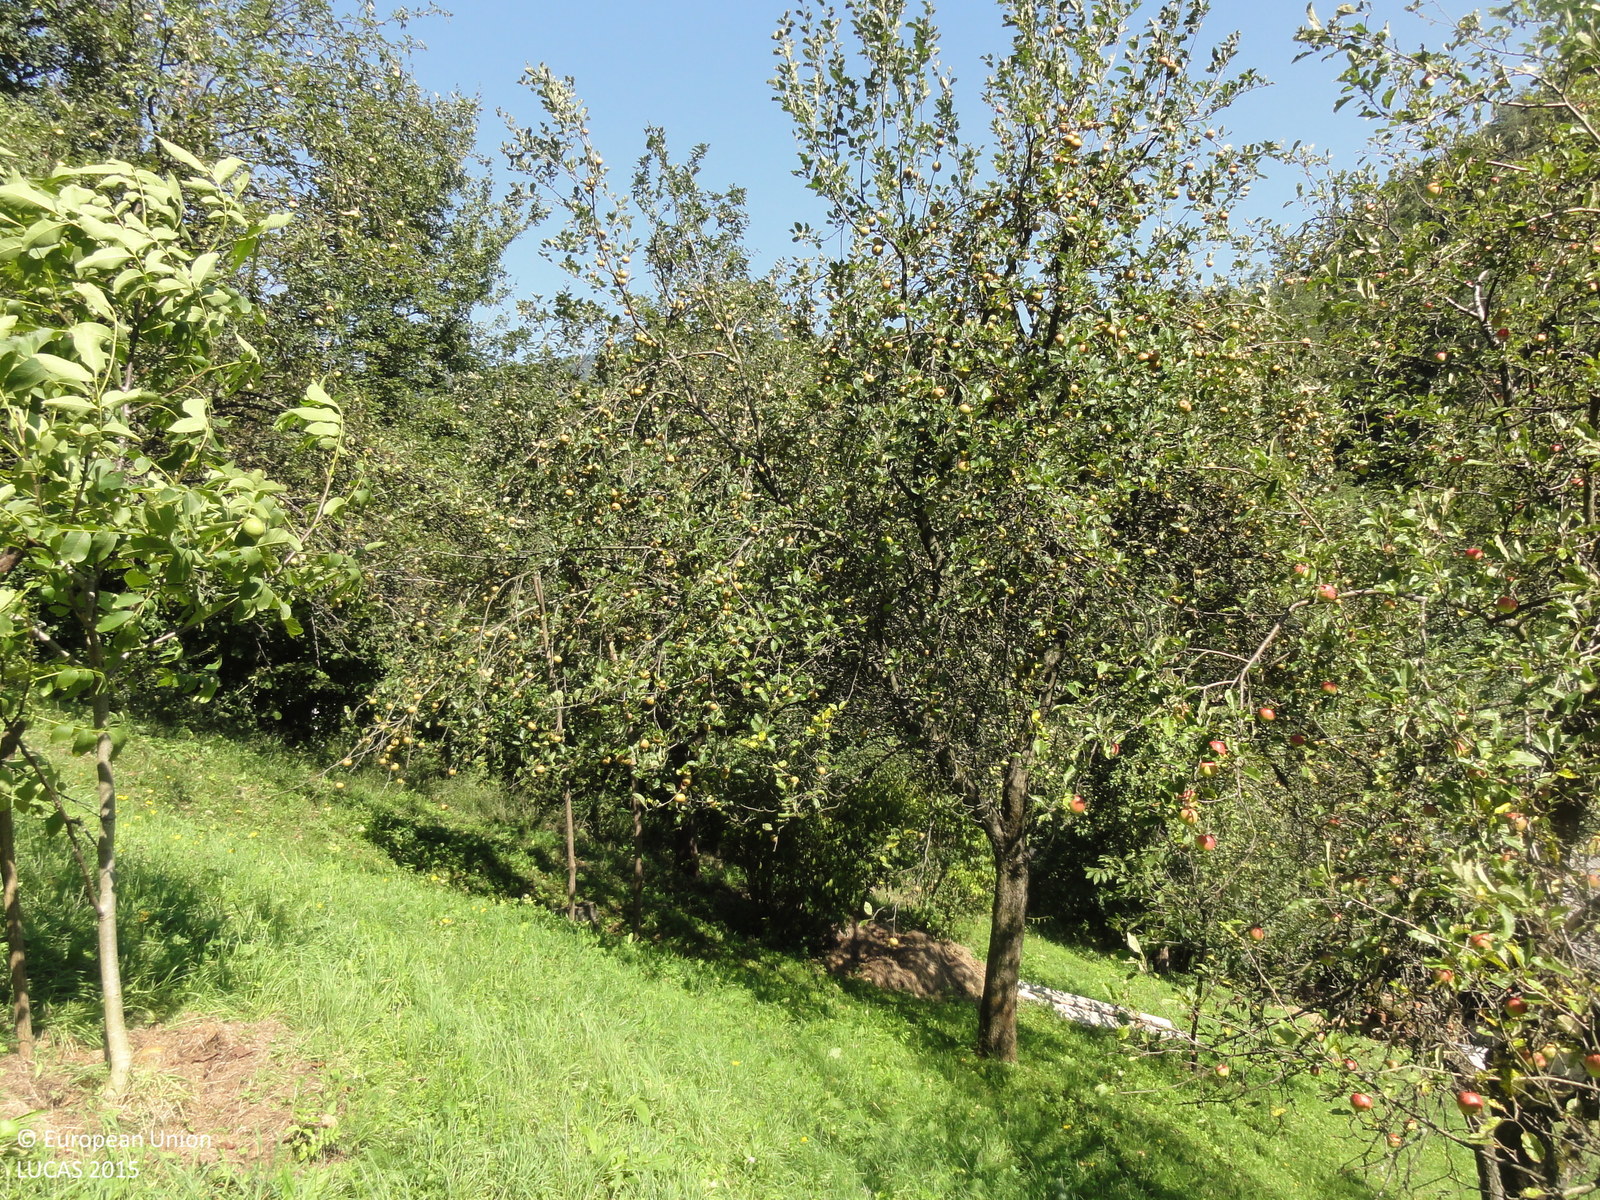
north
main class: Cropland
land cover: Apple fruit
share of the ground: 50 - 75 %
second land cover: Grassland without tree/shrub cover
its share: > 75 %
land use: Kitchen garden
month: August
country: SI
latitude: 46.1581
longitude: 15.0864
